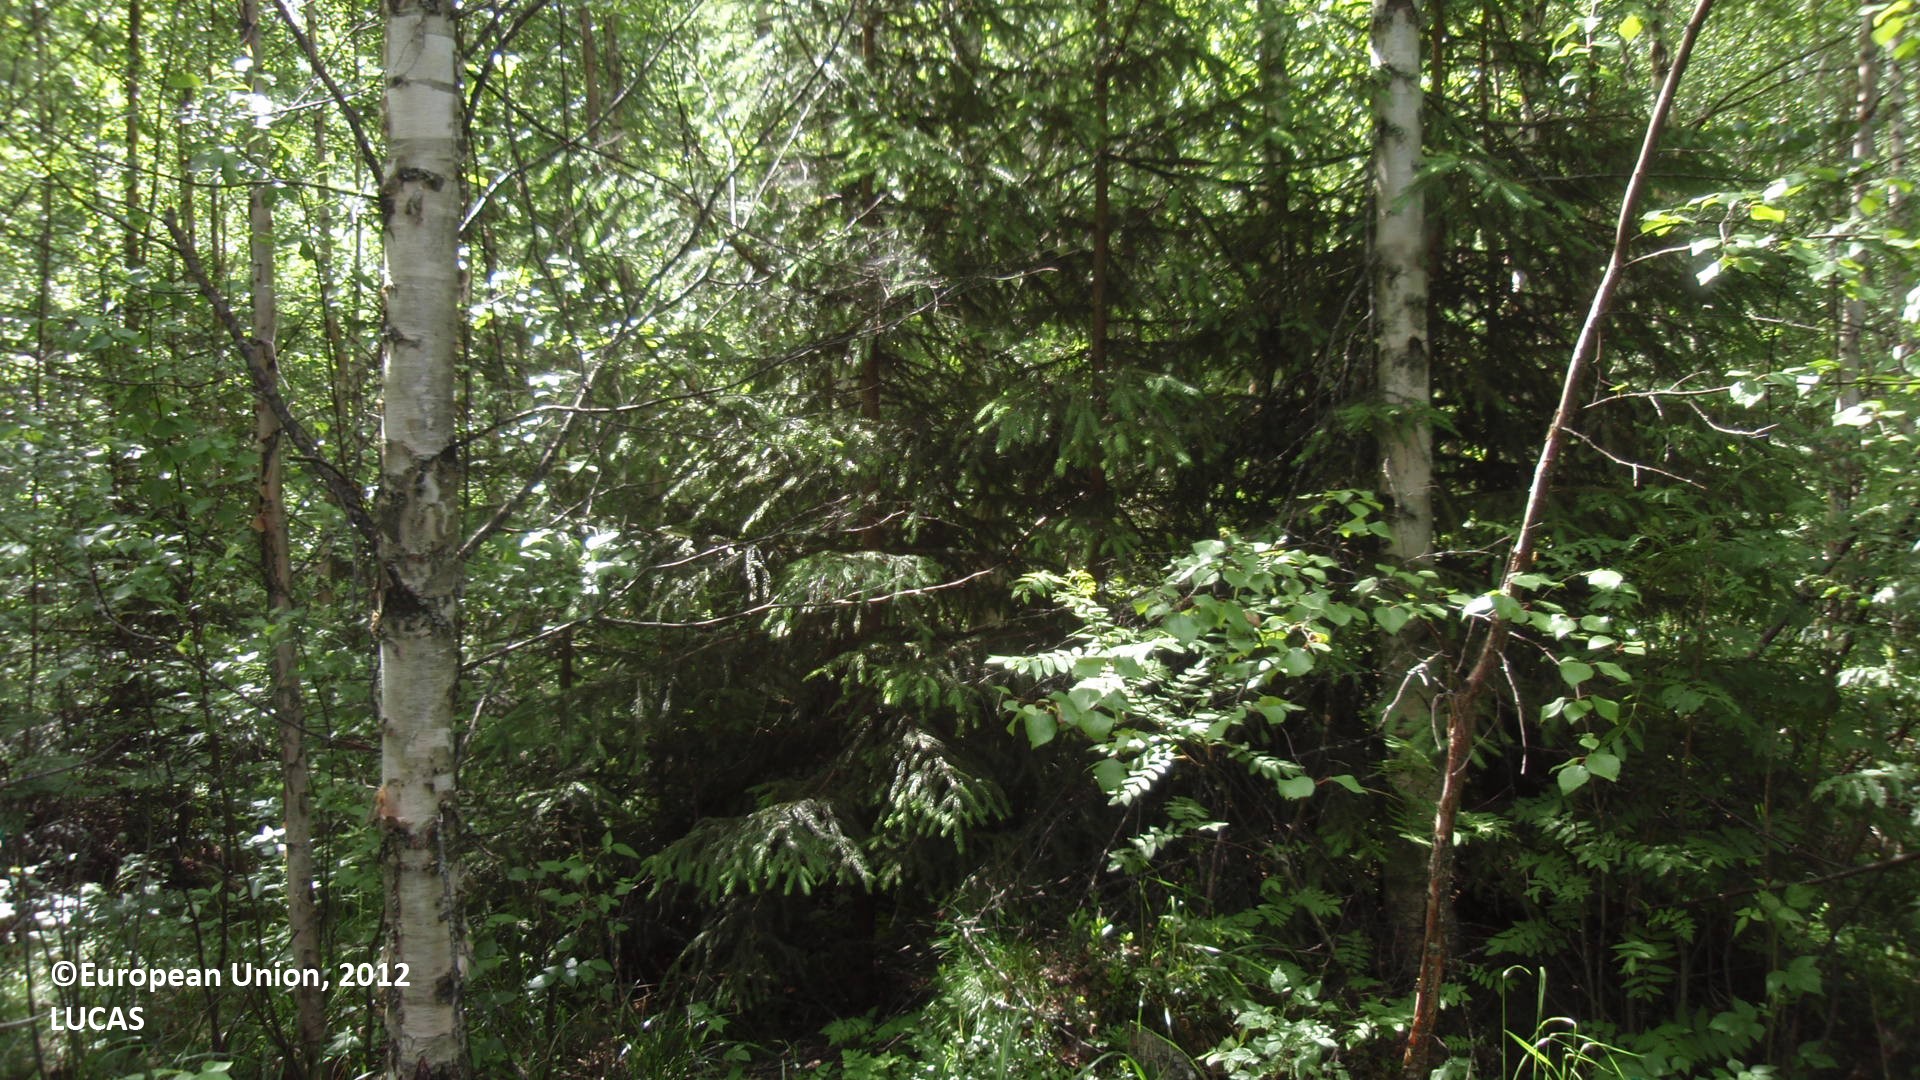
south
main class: Woodland
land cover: Broadleaved woodland
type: boreal forest
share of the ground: > 75 %
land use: Forestry
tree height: > 5 m
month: June
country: FI
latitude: 61.5197
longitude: 26.8699
